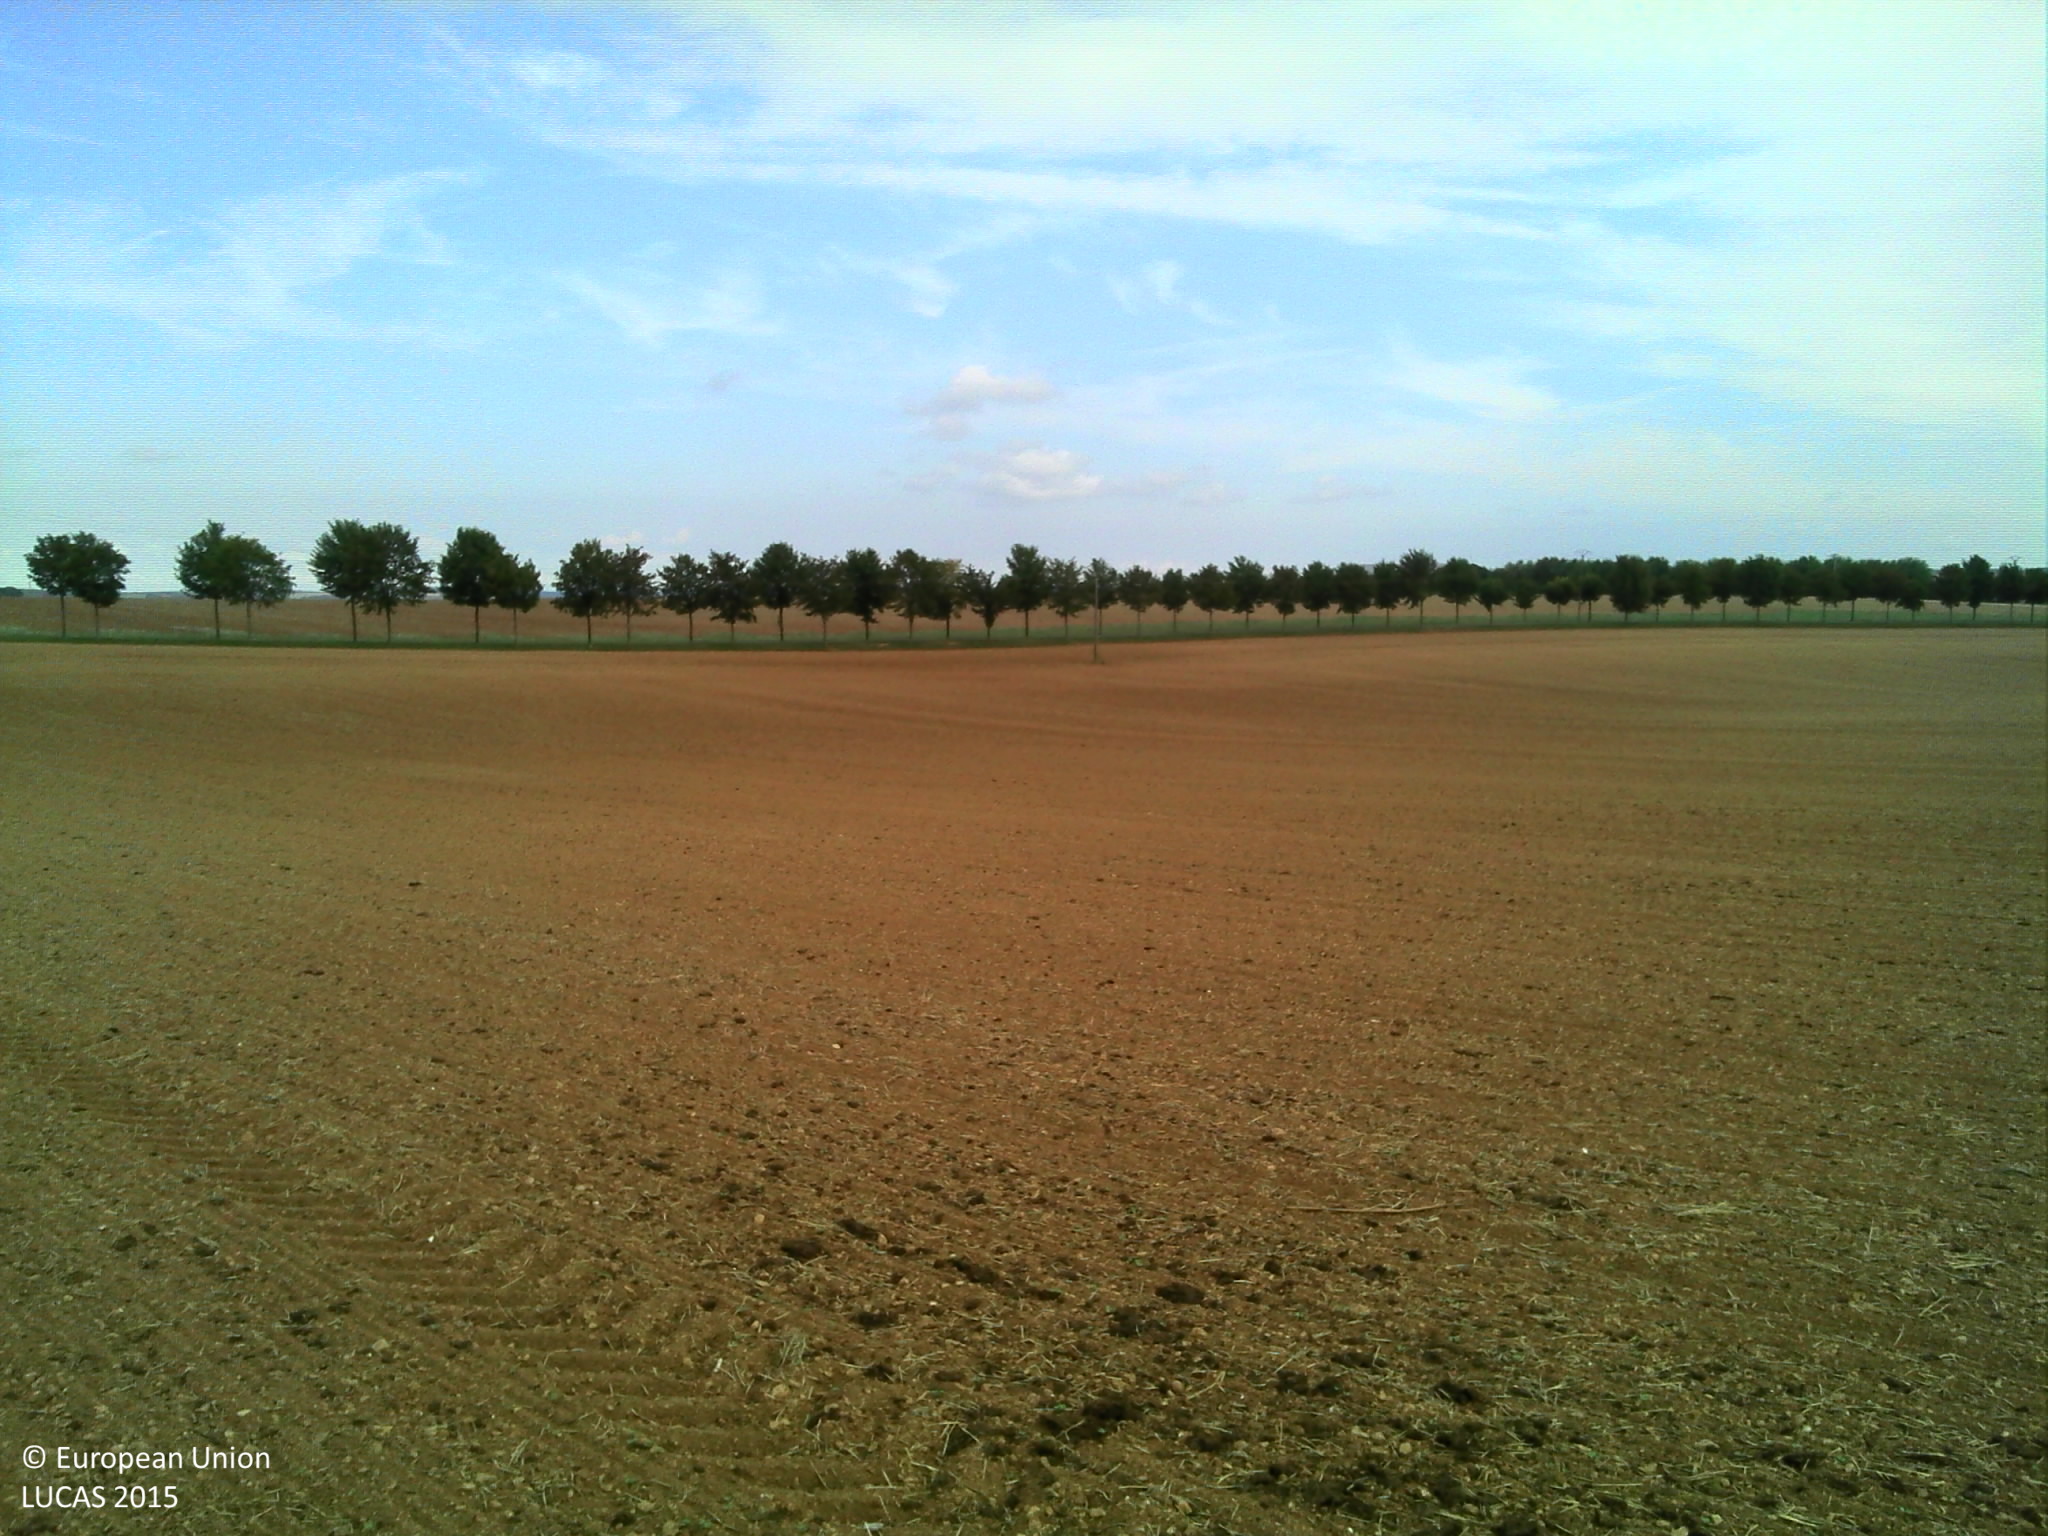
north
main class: Cropland
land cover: Barley
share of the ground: 10 - 25 %
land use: Agriculture (excluding fallow land and kitchen gardens)
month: September
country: FR
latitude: 47.6176
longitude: 4.8773
